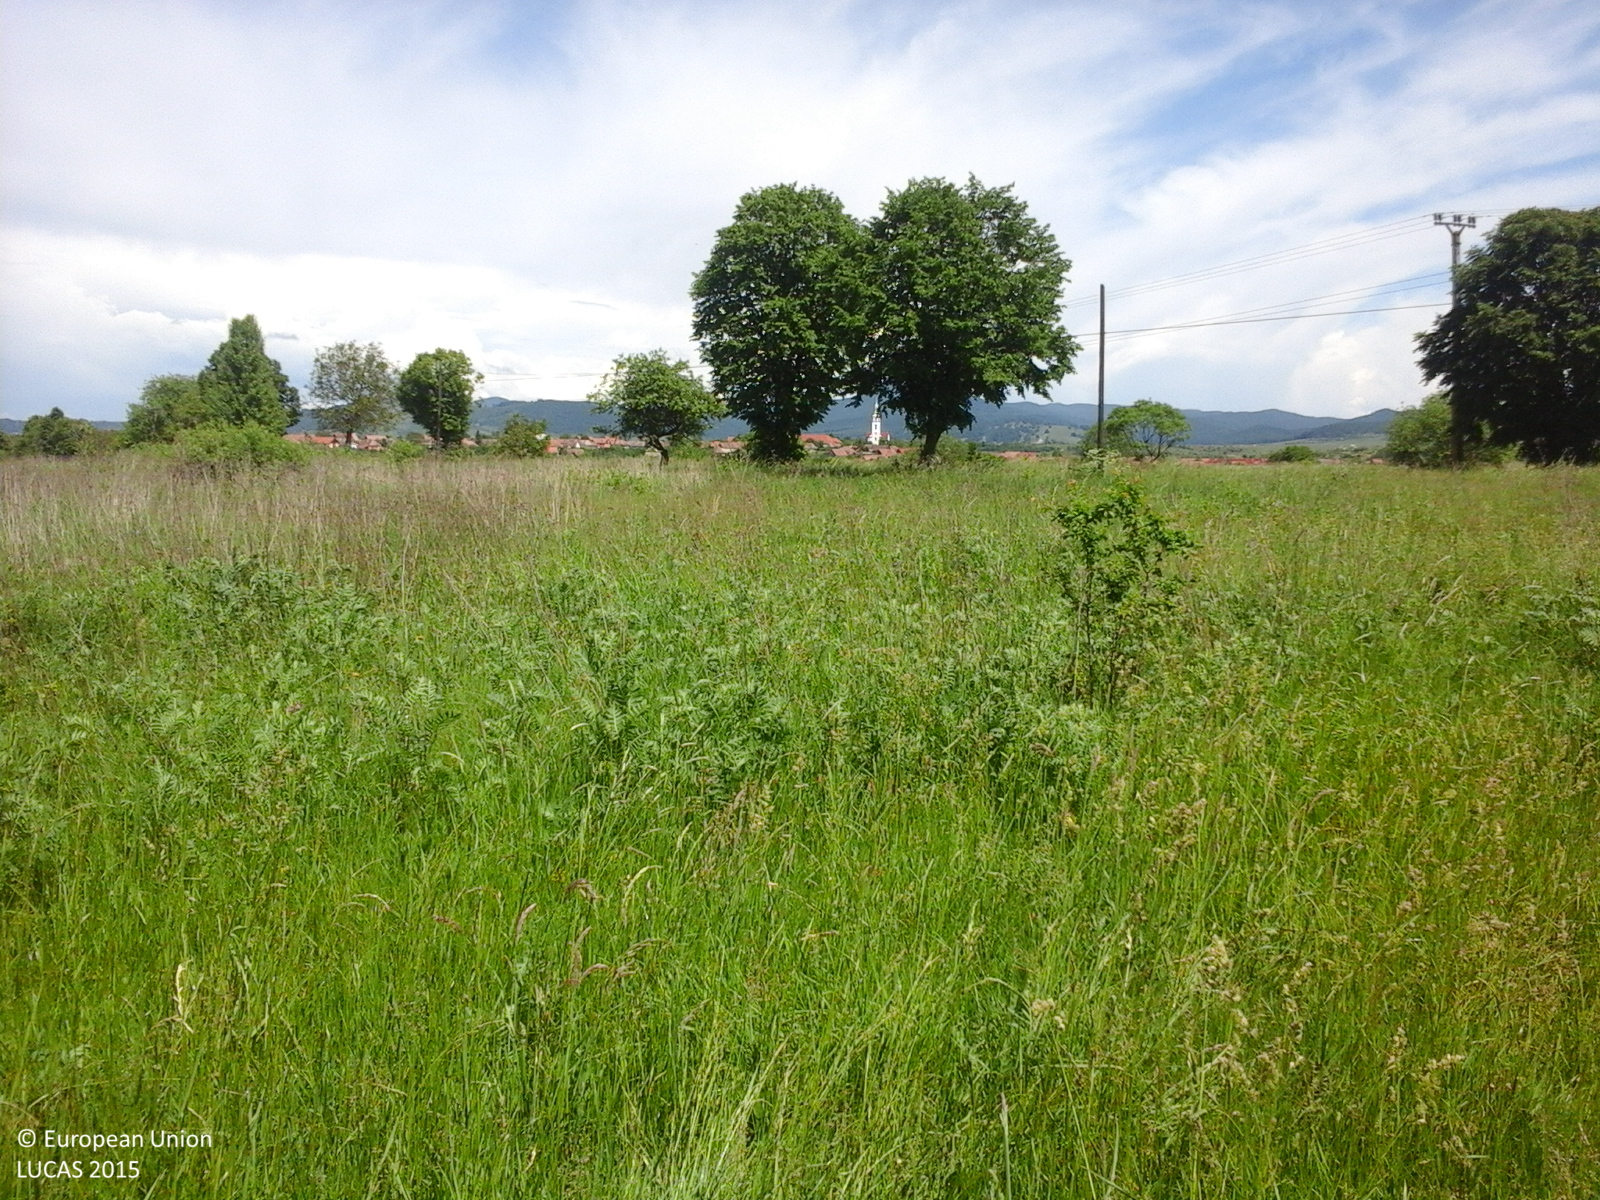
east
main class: Grassland
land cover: Spontaneously vegetated surfaces
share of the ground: > 75 %
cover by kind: herbaceous plants 100 %
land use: Fallow land
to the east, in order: Spontaneously vegetated surfaces; Ditches and canals; Spontaneously vegetated surfaces; Electric lines; Lines of trees; Paved roads, cycling and walking lanes; Grass margins; Ditches and canals; Lines of trees; Electric lines; Grassland without tree/shrub cover; Ditches and canals; Lines of trees; Other leguminous and mixtures for fodder; Ditches and canals; Grassland without tree/shrub cover; Ditches and canals; Grassland without tree/shrub cover; Ditches and canals; Grassland without tree/shrub cover
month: May
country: RO
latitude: 45.8466
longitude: 25.1752
